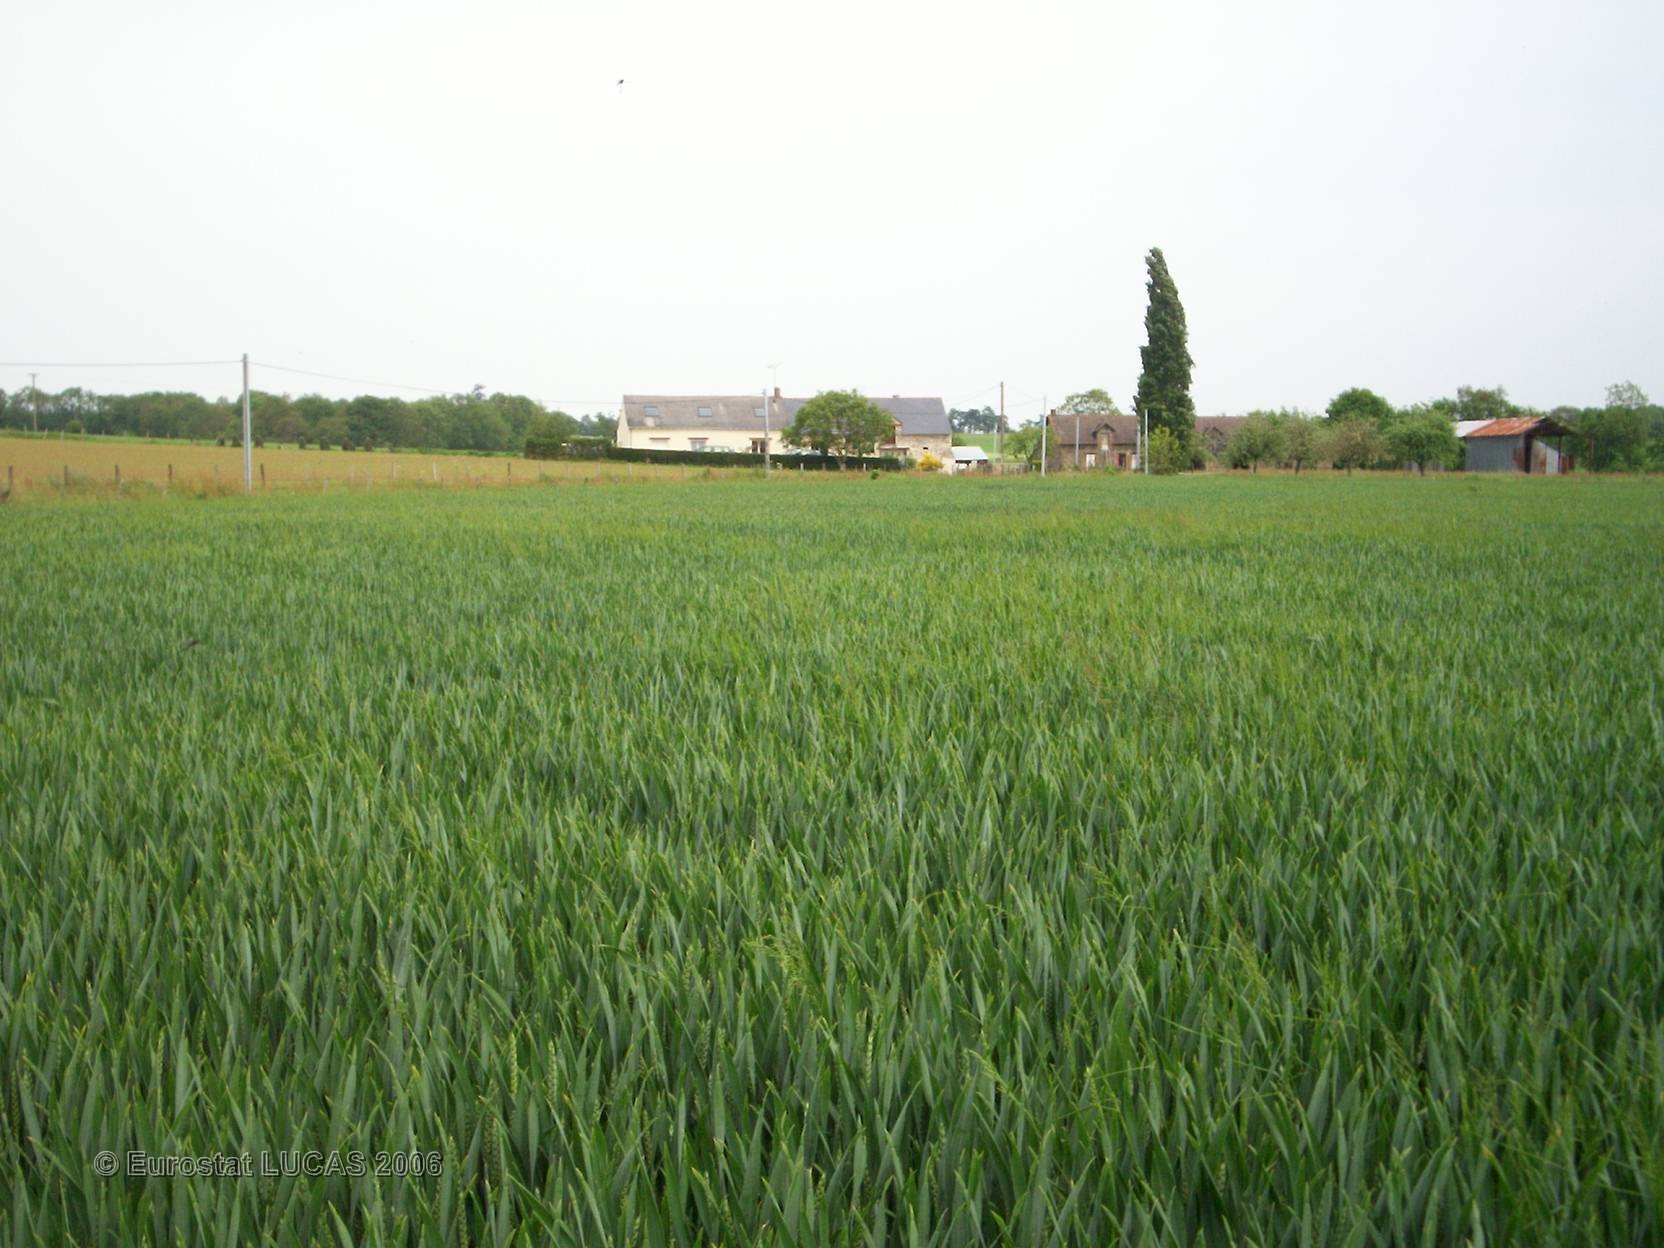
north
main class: Cropland
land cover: Common wheat
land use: Agriculture (excluding fallow land and kitchen gardens)
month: May
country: FR
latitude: 47.6279
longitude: -1.4203
